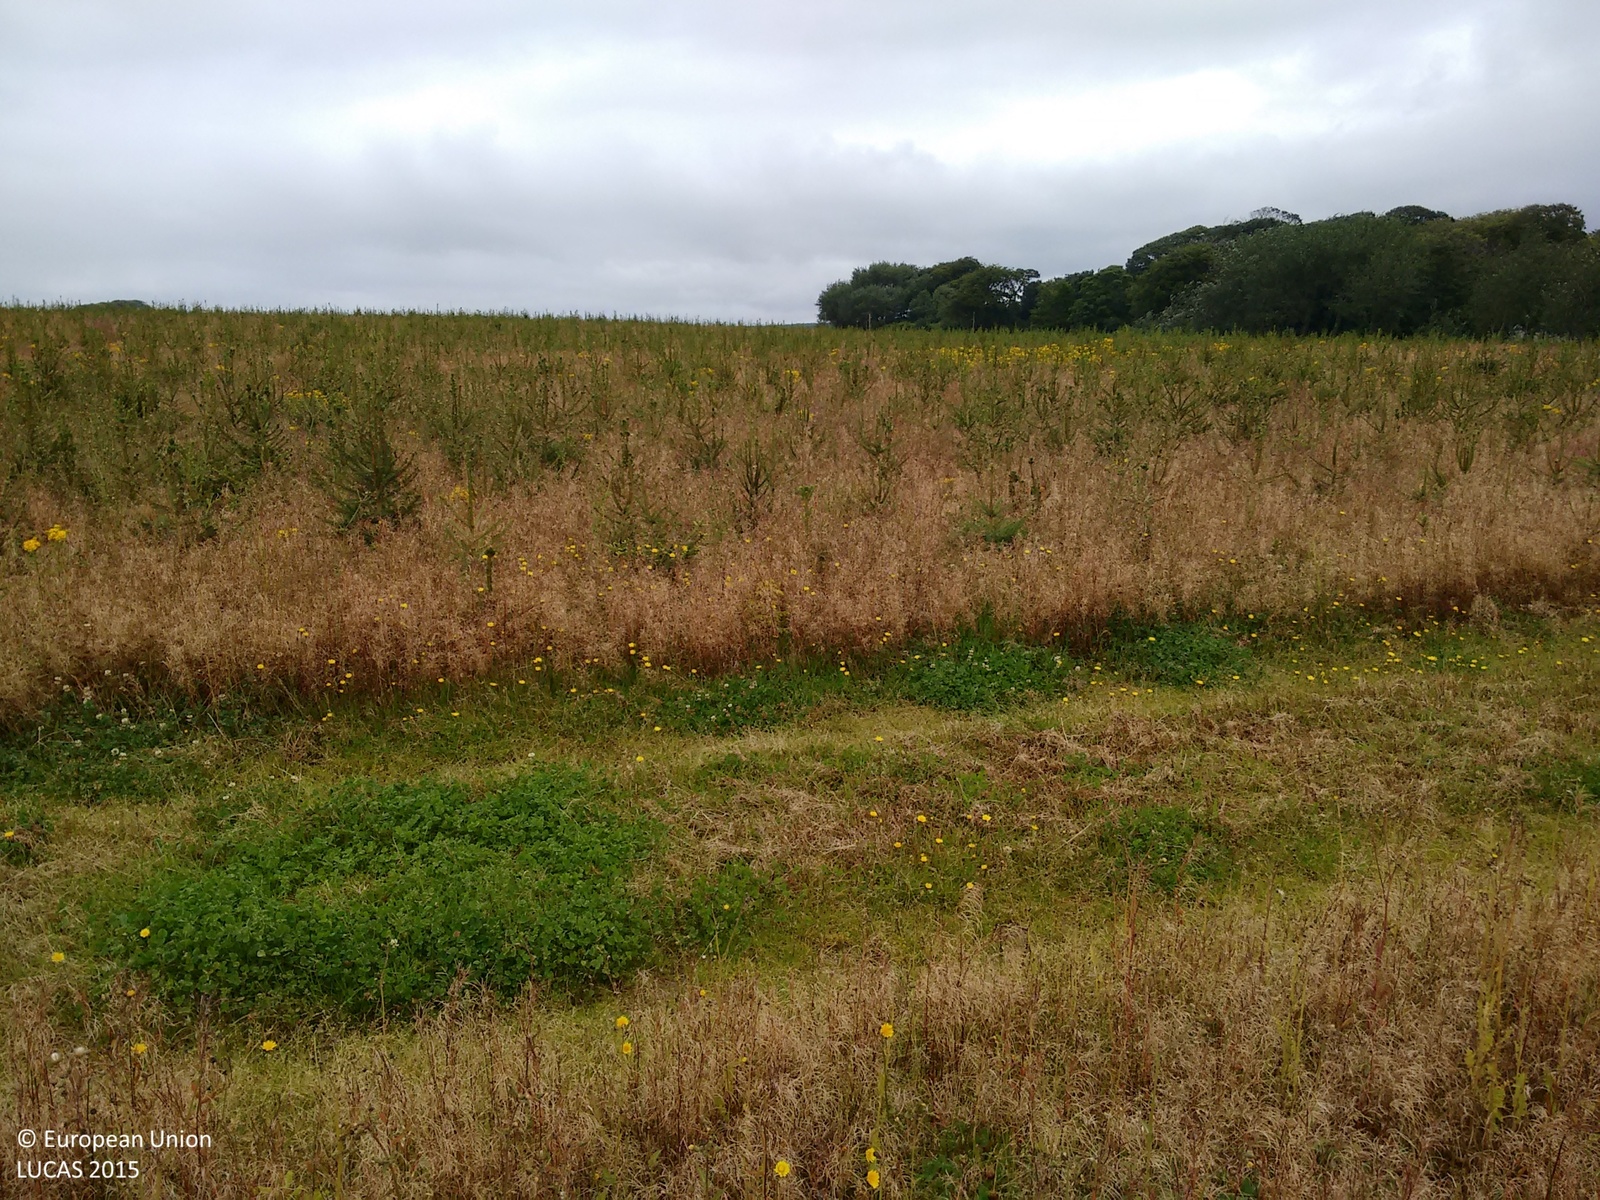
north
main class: Woodland
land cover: Spruce dominated coniferous woodland
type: exotic forest
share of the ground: < 10 %
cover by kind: herbaceous plants 90 %, coniferous forest trees 10 %
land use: Forestry
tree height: < 5 m
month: September
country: GB
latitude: 57.6902
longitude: -3.4033
